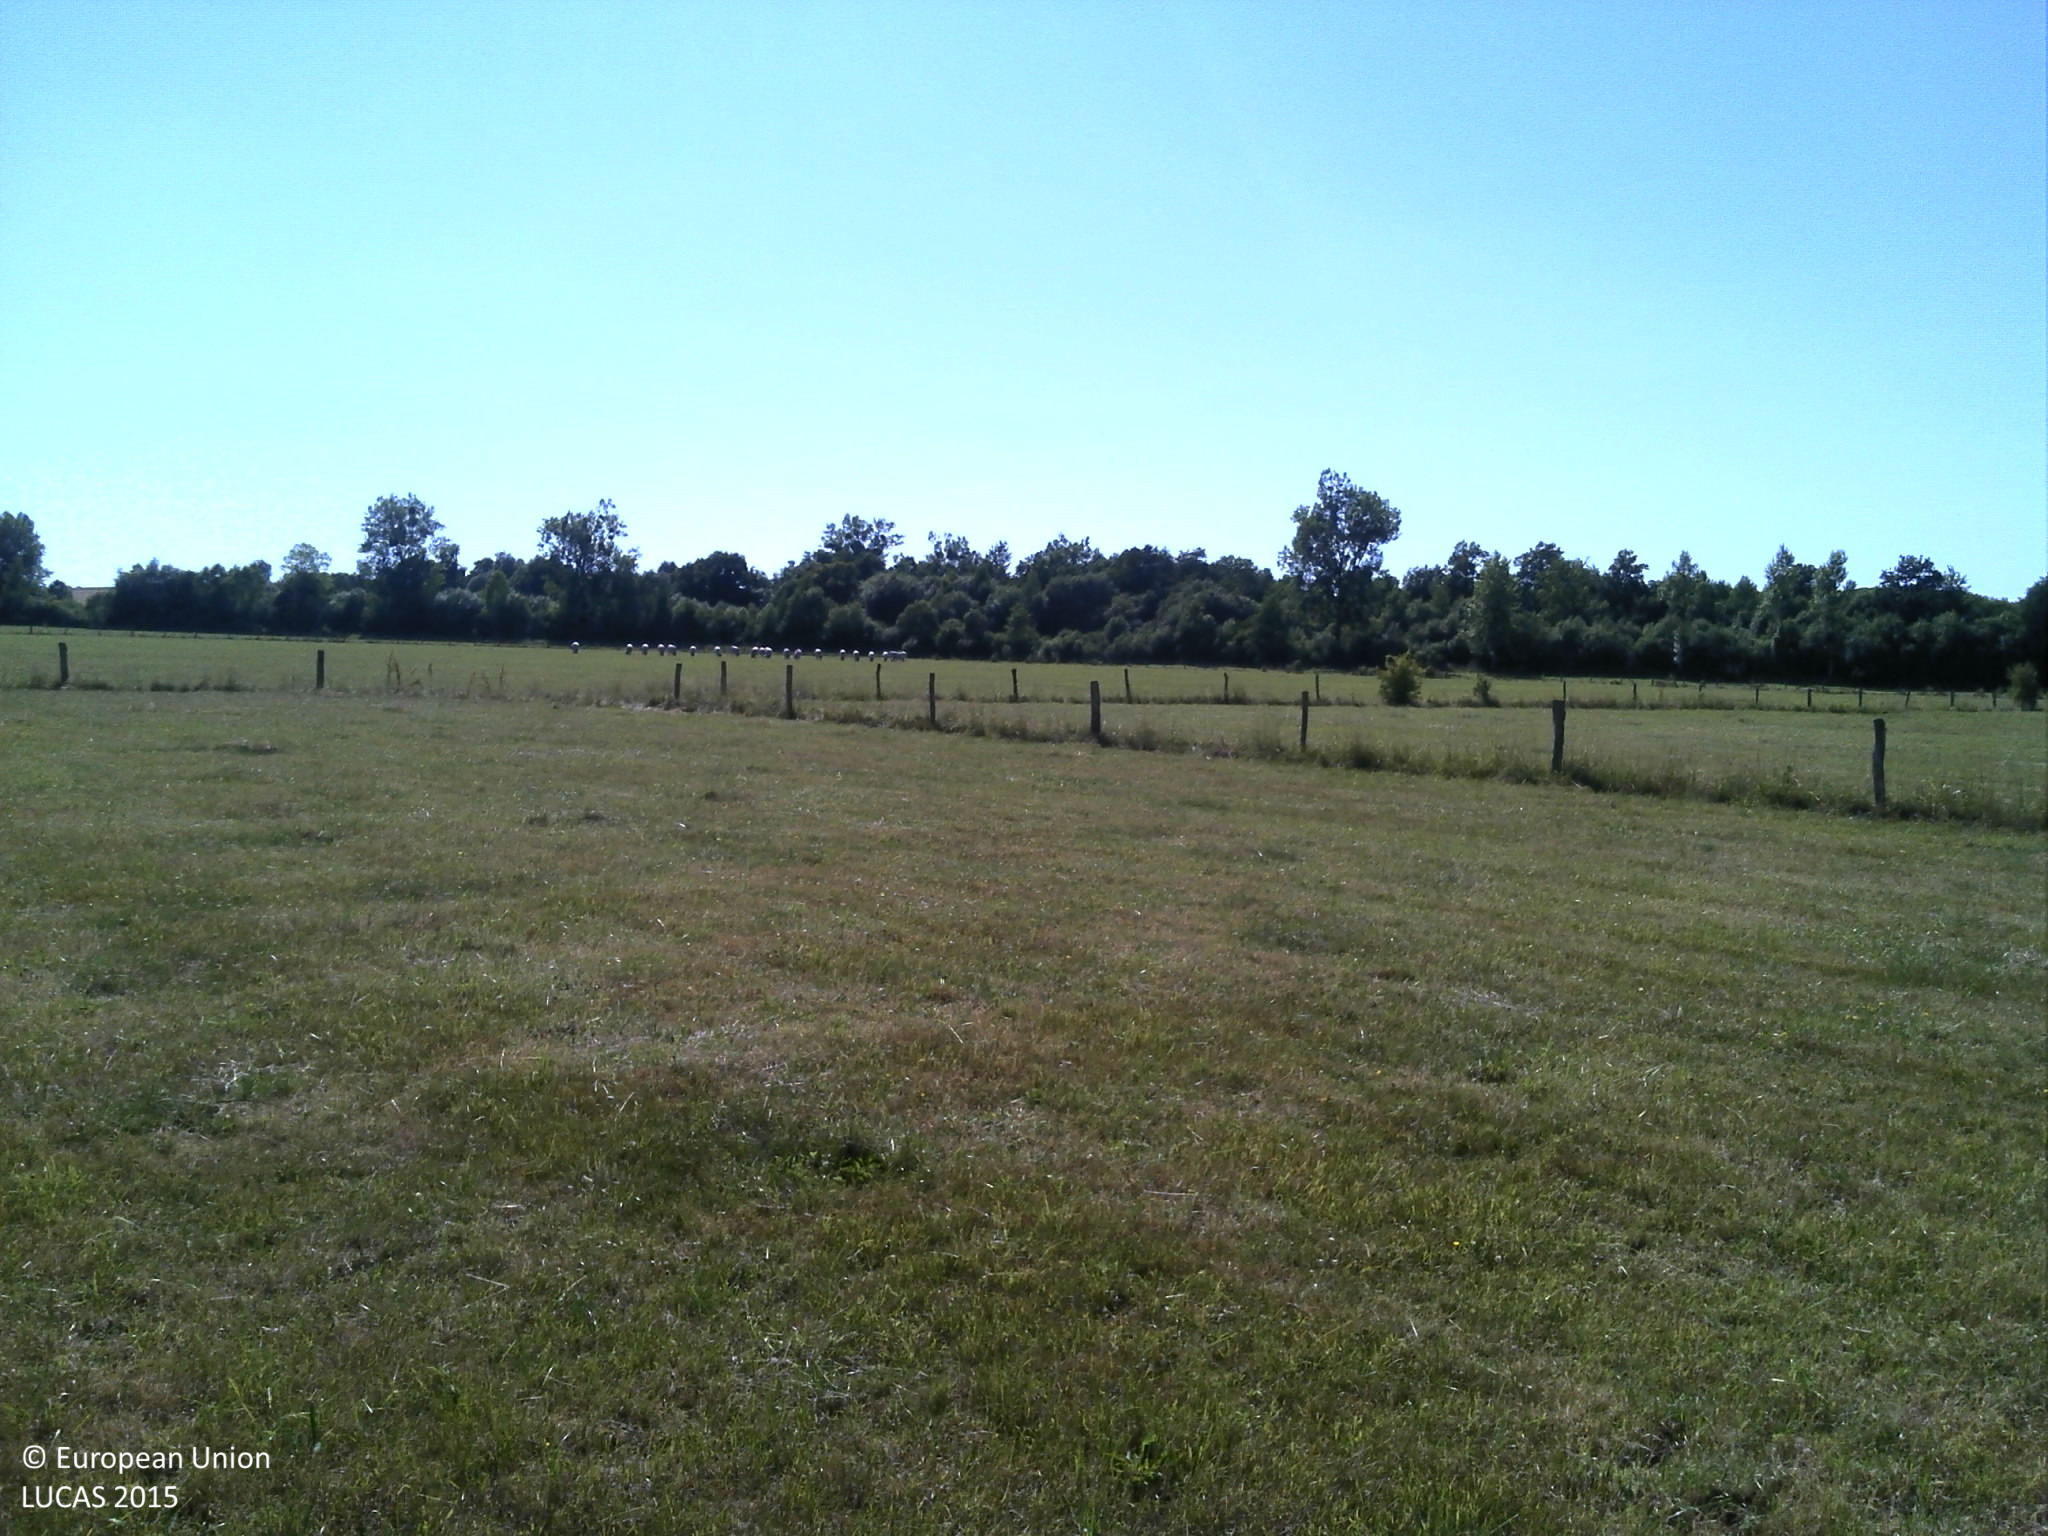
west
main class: Grassland
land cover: Grassland without tree/shrub cover
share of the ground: > 75 %
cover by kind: herbaceous plants 100 %
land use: Agriculture (excluding fallow land and kitchen gardens)
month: July
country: FR
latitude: 49.5258
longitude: 4.8164
